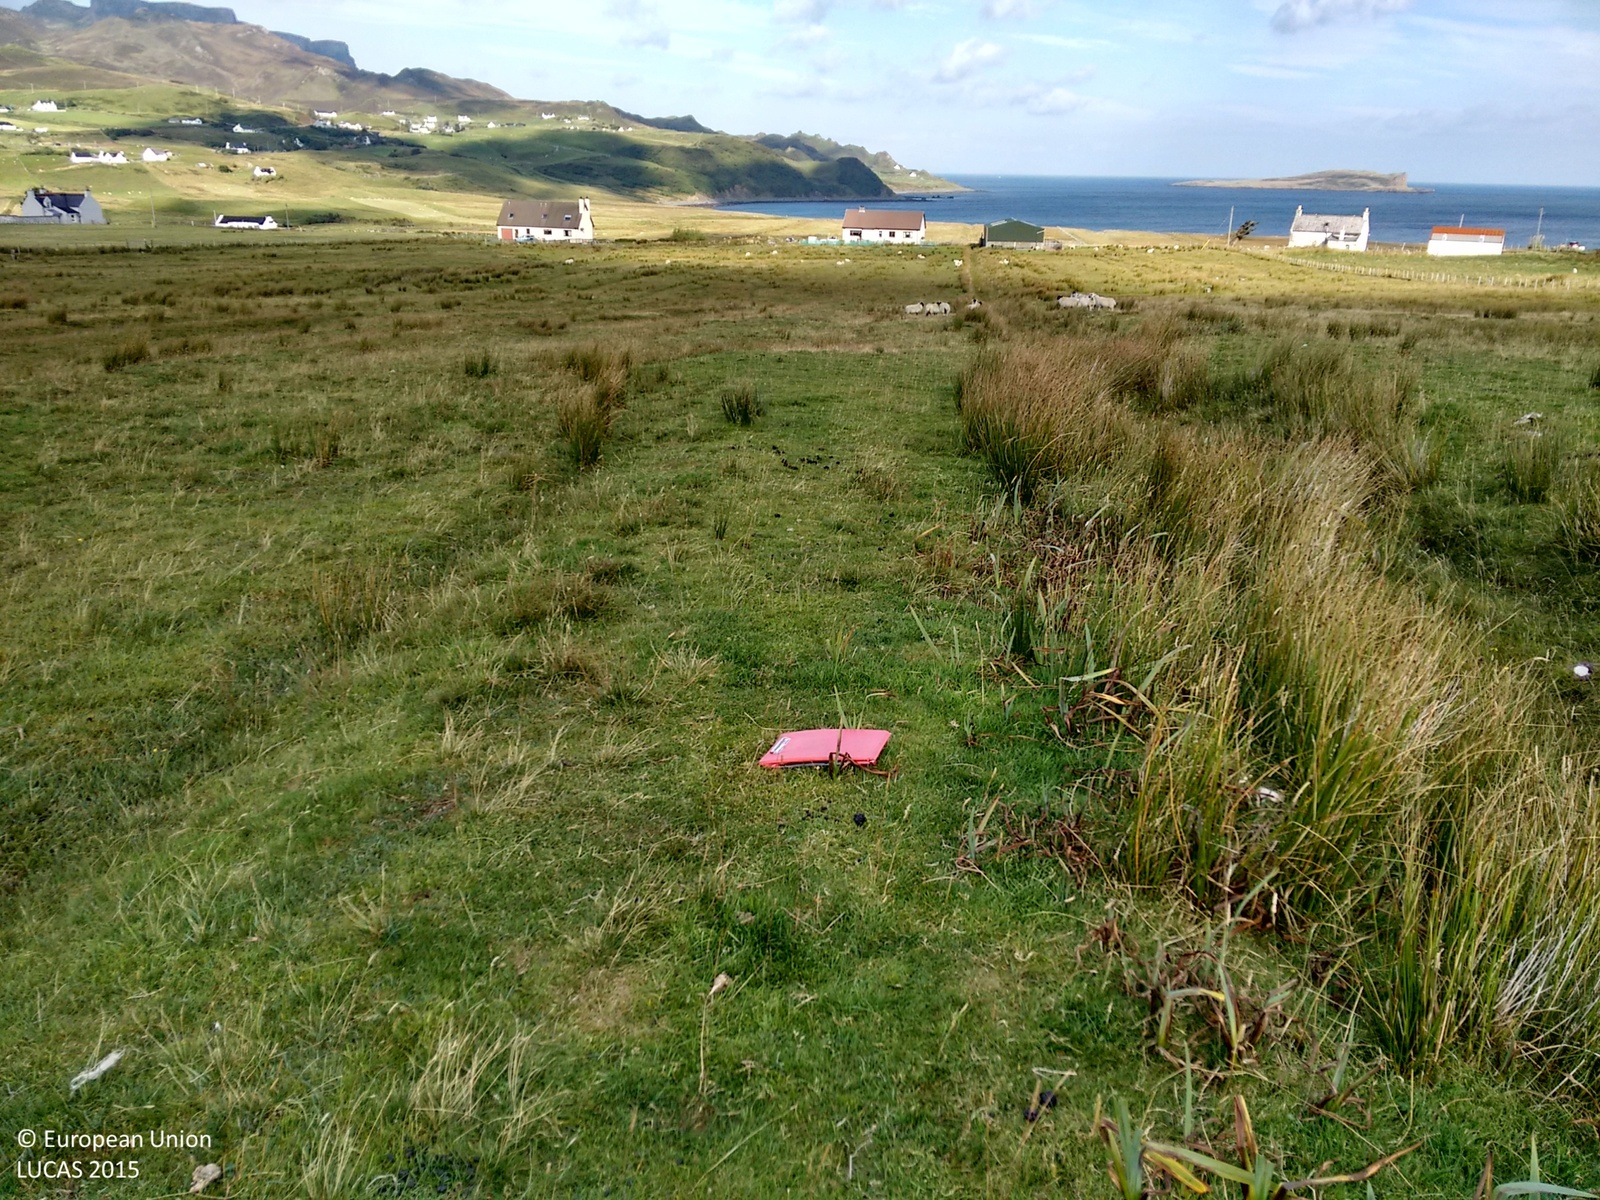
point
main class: Grassland
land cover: Grassland without tree/shrub cover
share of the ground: > 75 %
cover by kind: herbaceous plants 100 %
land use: Agriculture (excluding fallow land and kitchen gardens)
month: September
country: GB
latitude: 57.6281
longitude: -6.2268
